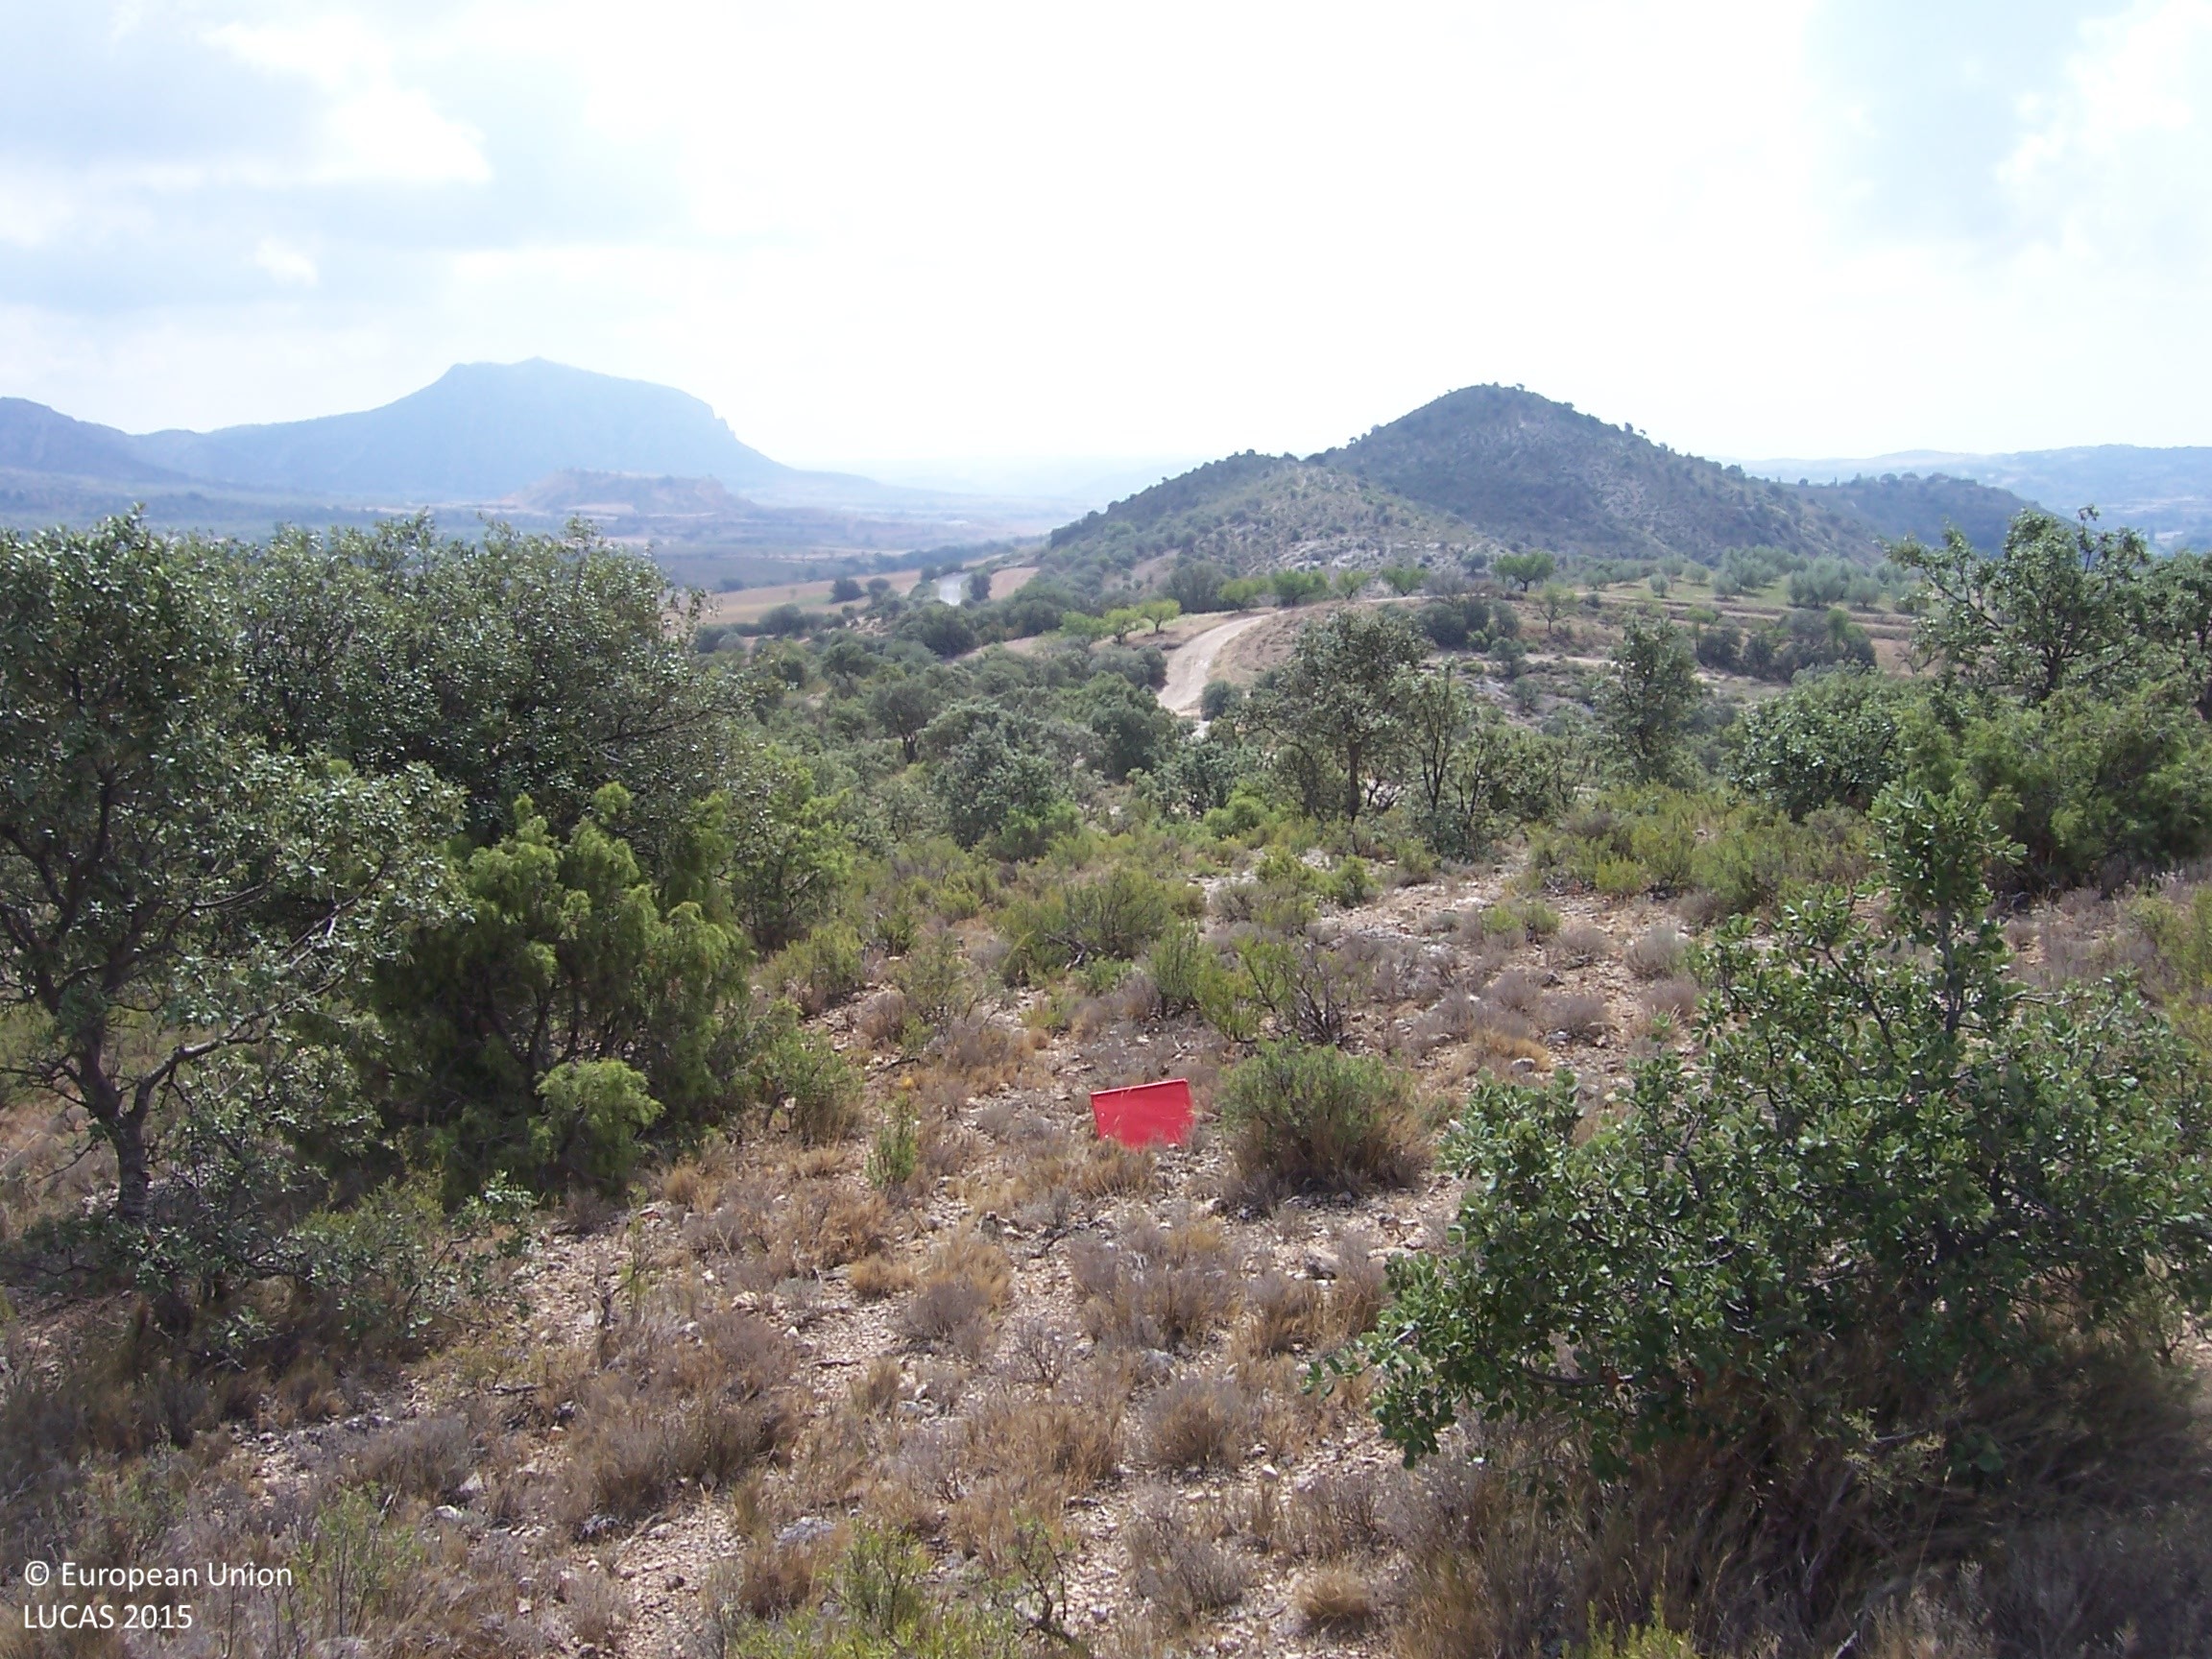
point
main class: Woodland
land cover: Broadleaved woodland
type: broadleaved evergreen forest
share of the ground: > 75 %
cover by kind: herbaceous plants 50 %, shrubs 20 %, broadleaved forest trees 15 %, unconsolidated bare surface 10 %, consolidated bare surface 5 %
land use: Semi-natural and natural areas not in use
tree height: < 5 m
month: August
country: ES
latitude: 41.8975
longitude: 0.4988
